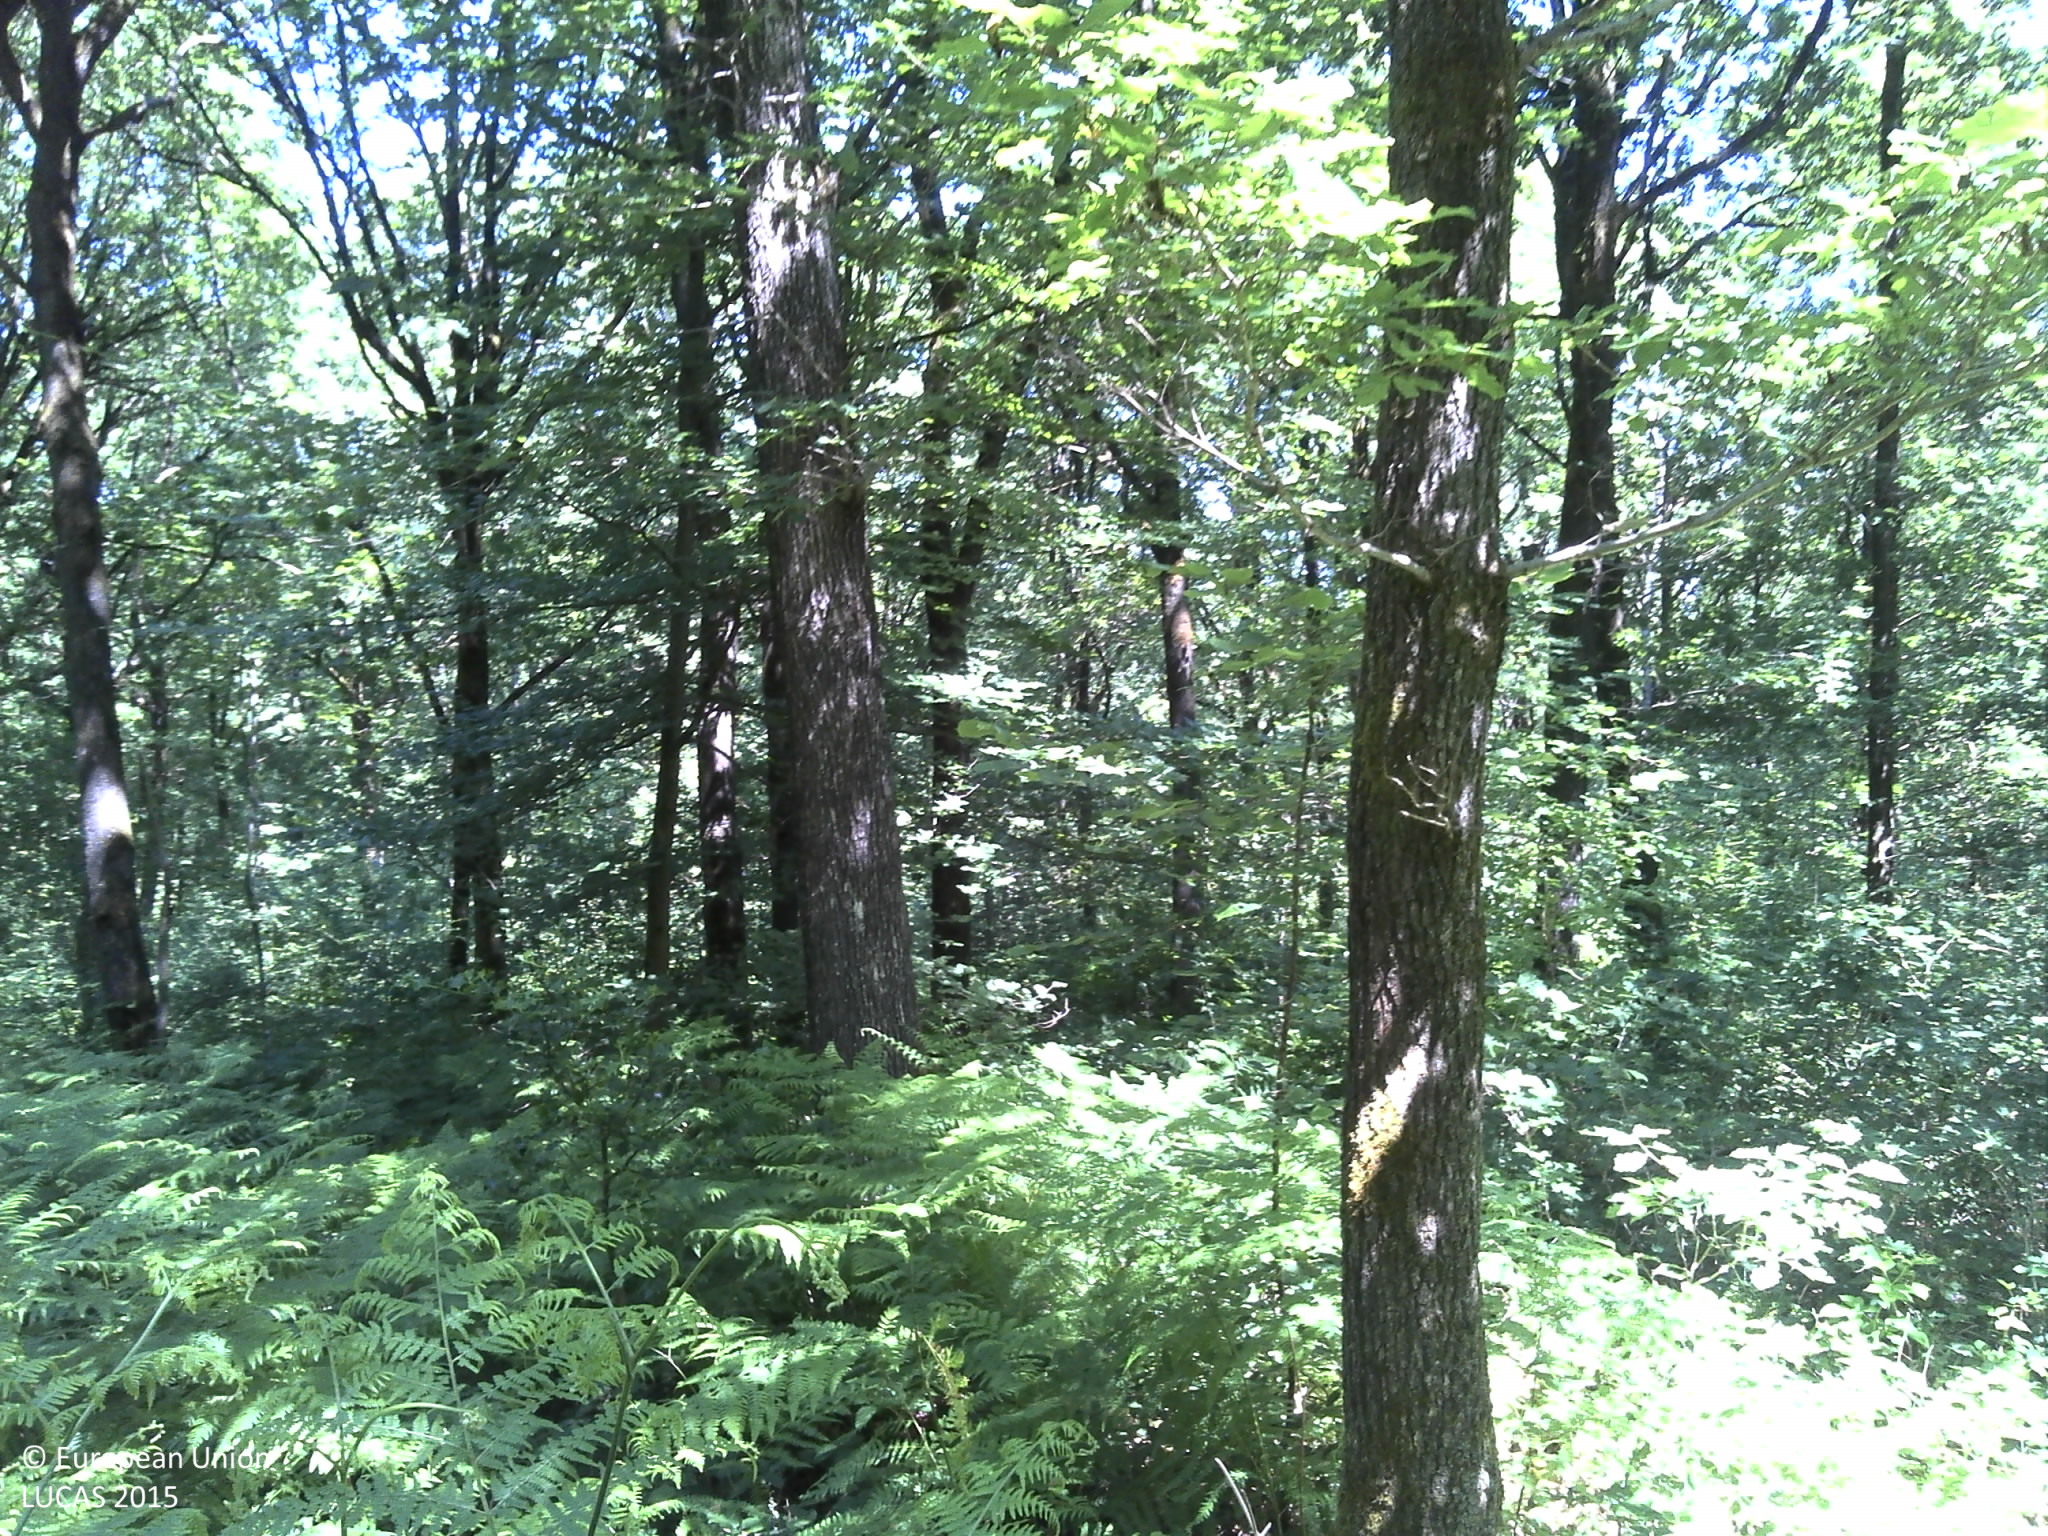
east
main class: Woodland
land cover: Broadleaved woodland
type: acidophilous oak and oak-birch forest
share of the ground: 50 - 75 %
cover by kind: broadleaved forest trees 70 %, herbaceous plants 25 %, consolidated bare surface 5 %
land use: Forestry
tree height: > 5 m
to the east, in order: Broadleaved woodland; Tracks; Broadleaved woodland; Tracks; Broadleaved woodland
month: June
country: FR
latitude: 50.0842
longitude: 4.8119
